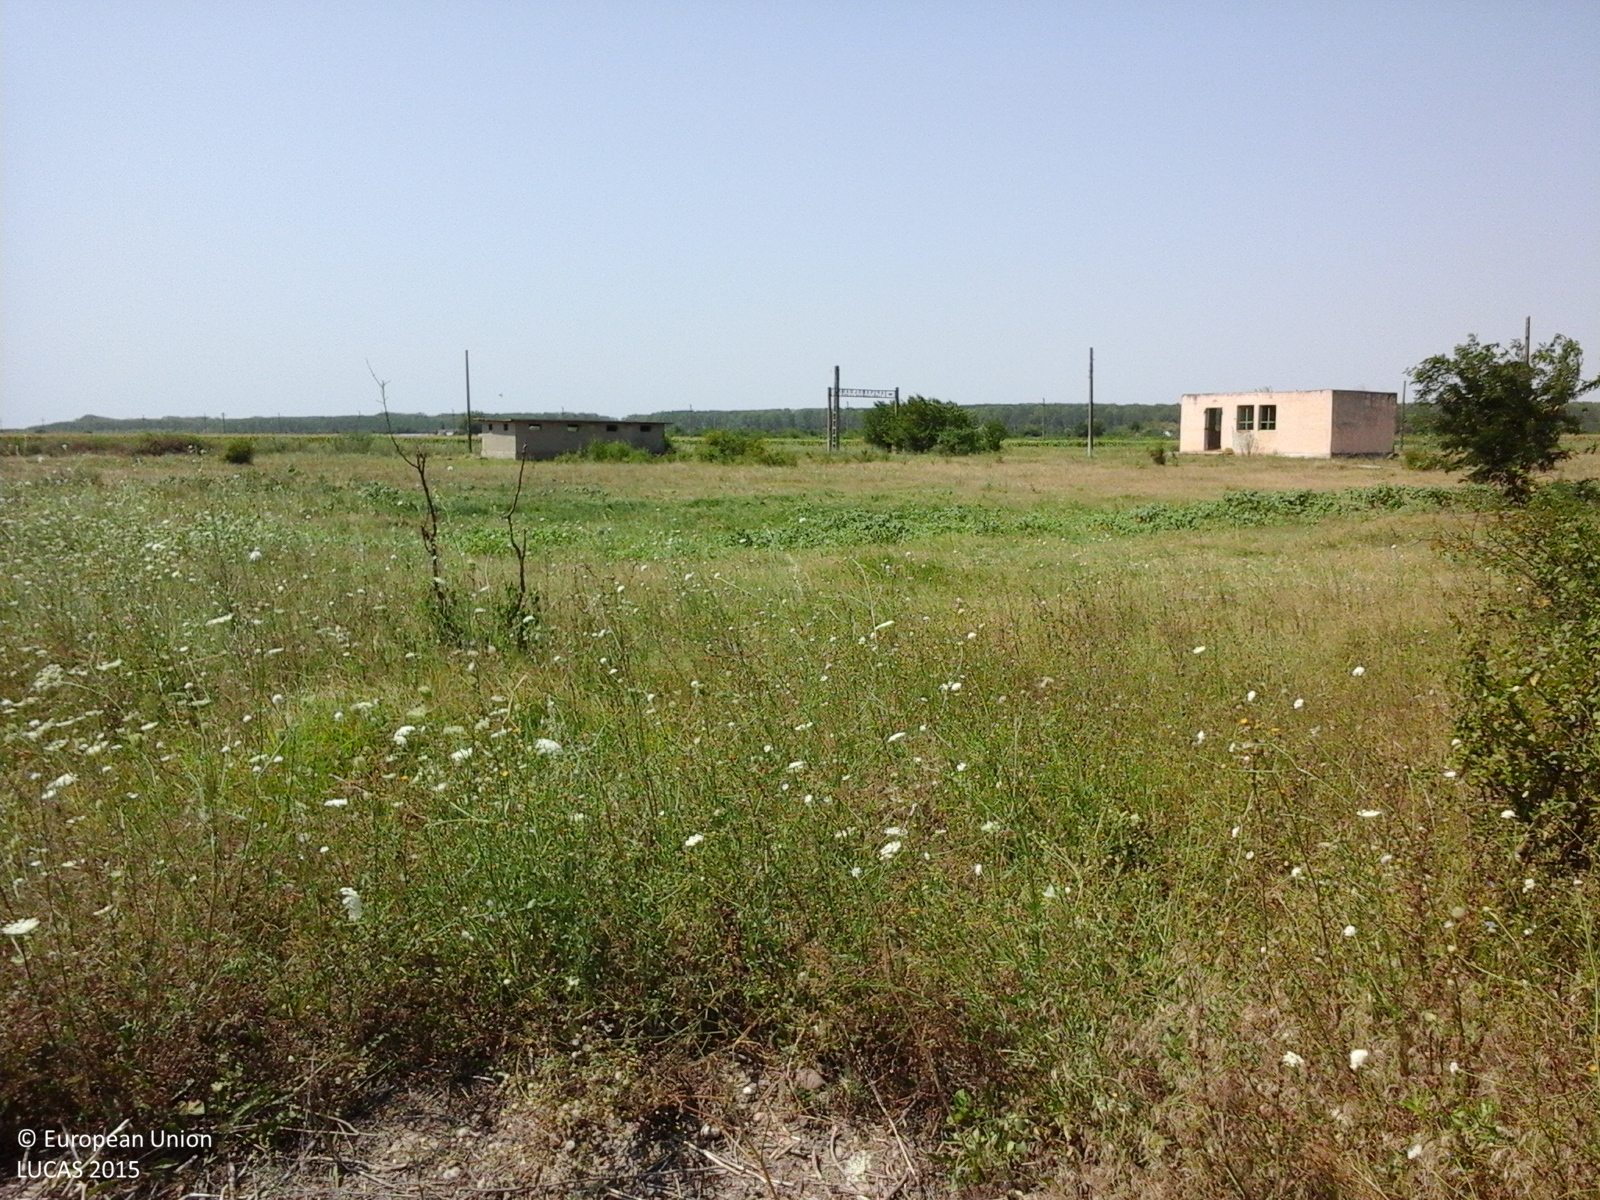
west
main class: Grassland
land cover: Spontaneously vegetated surfaces
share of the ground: > 75 %
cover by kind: herbaceous plants 100 %
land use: Fallow land
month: August
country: RO
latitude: 45.5289
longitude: 27.5564
